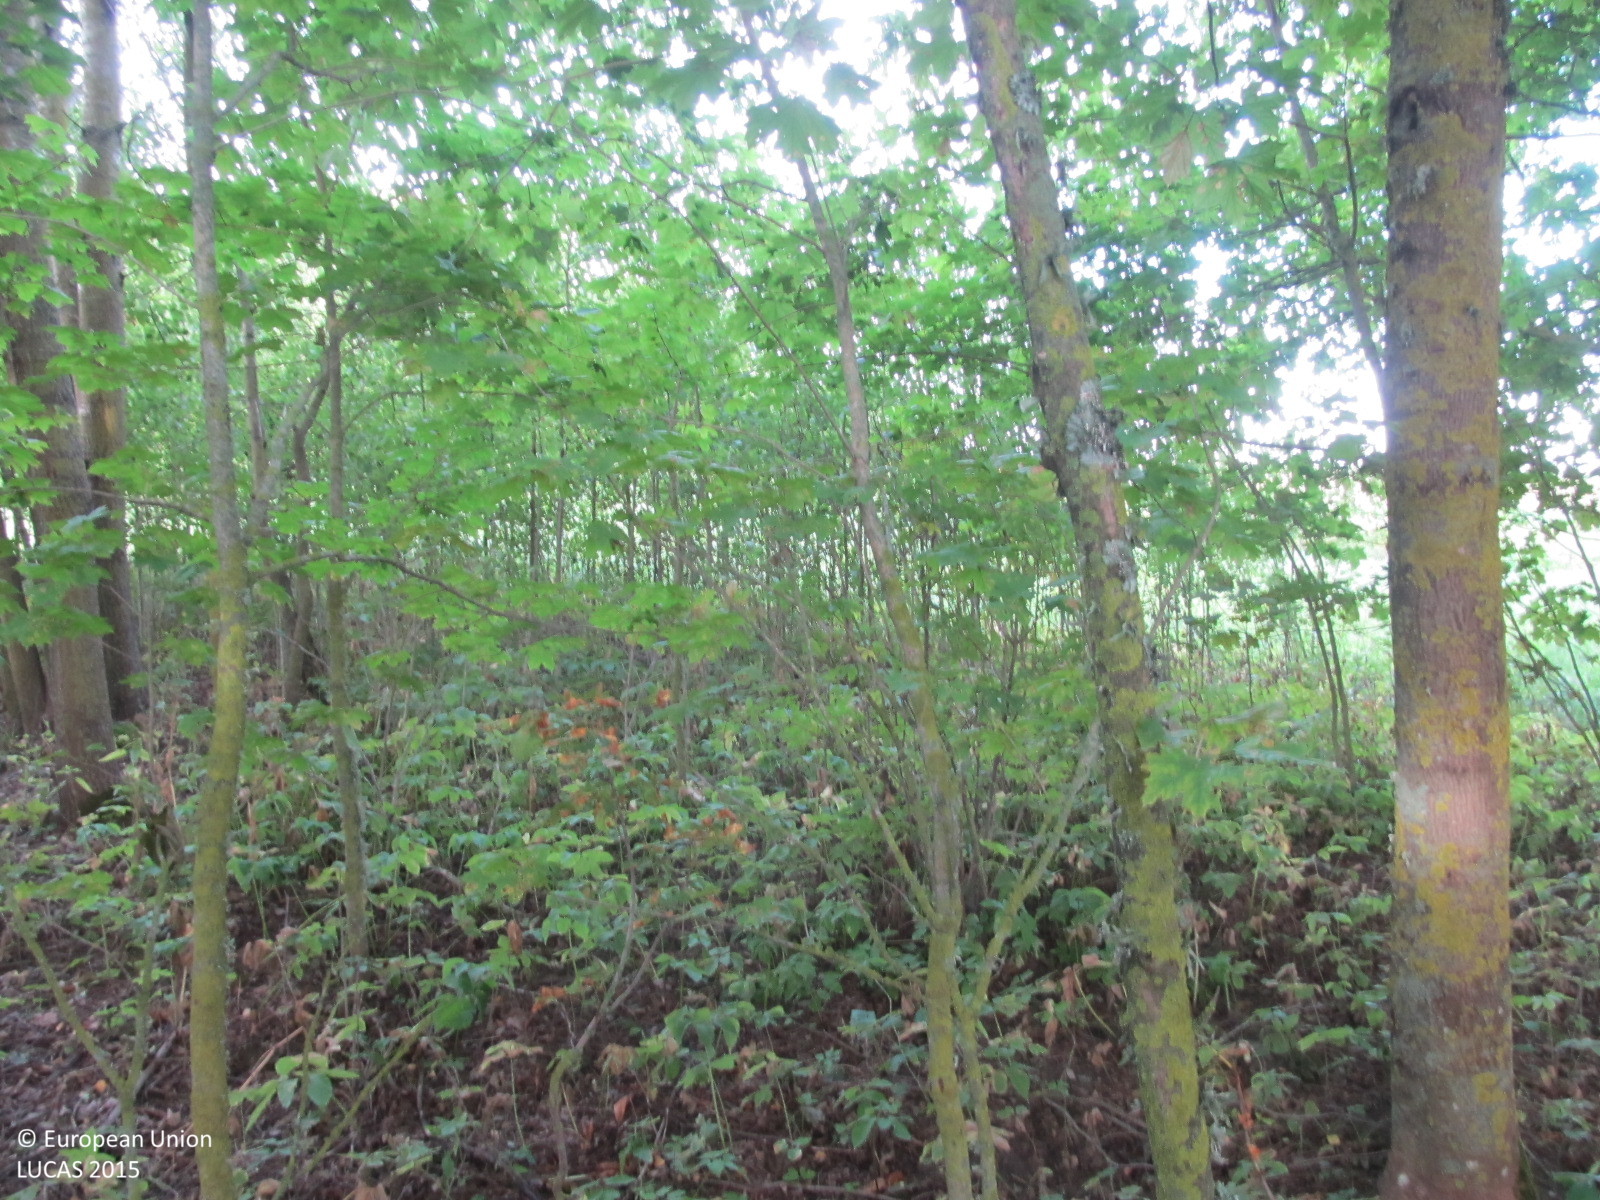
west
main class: Woodland
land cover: Broadleaved woodland
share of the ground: > 75 %
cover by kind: broadleaved forest trees 90 %, herbaceous plants 5 %, unconsolidated bare surface 5 %
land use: Forestry
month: September
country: LT
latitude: 56.3324
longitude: 23.2859
